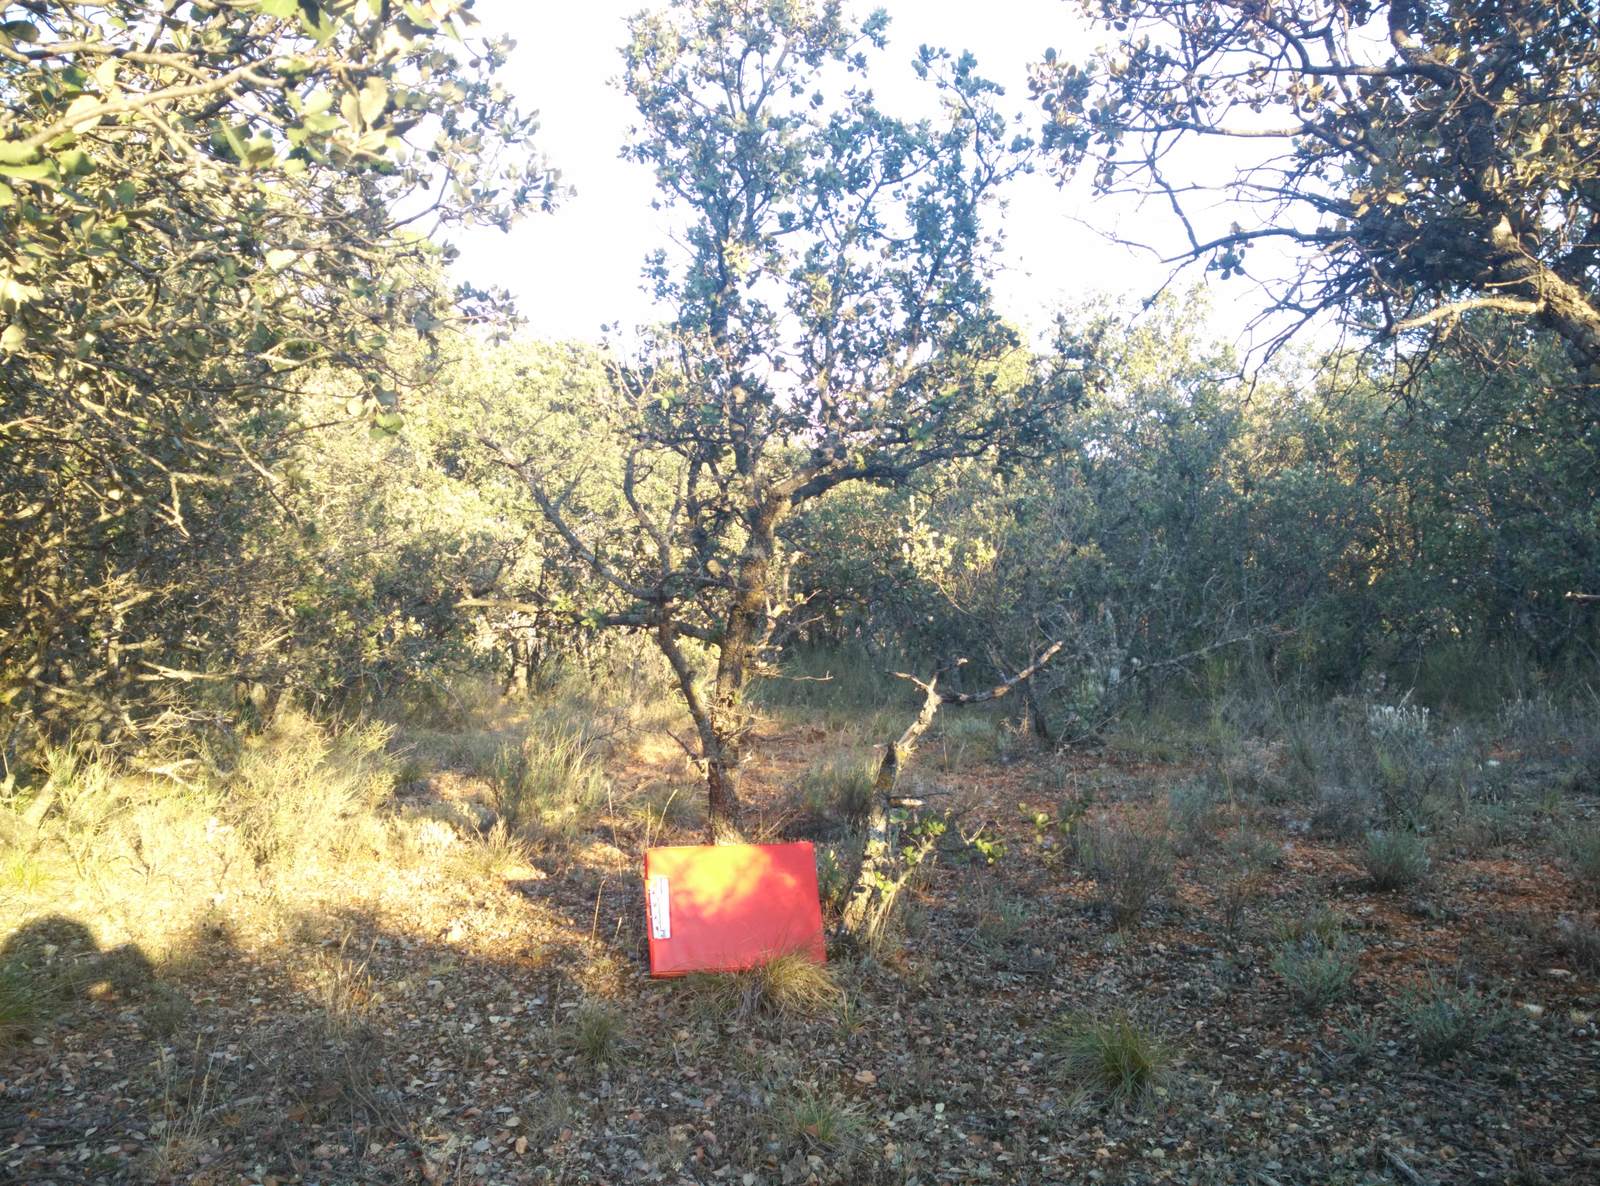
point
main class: Woodland
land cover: Broadleaved woodland
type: thermophilous deciduous forest
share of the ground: > 75 %
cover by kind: broadleaved forest trees 70 %, unconsolidated bare surface 25 %, herbaceous plants 5 %
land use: Semi-natural and natural areas not in use
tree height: > 5 m
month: July
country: ES
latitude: 40.9697
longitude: -2.7353
